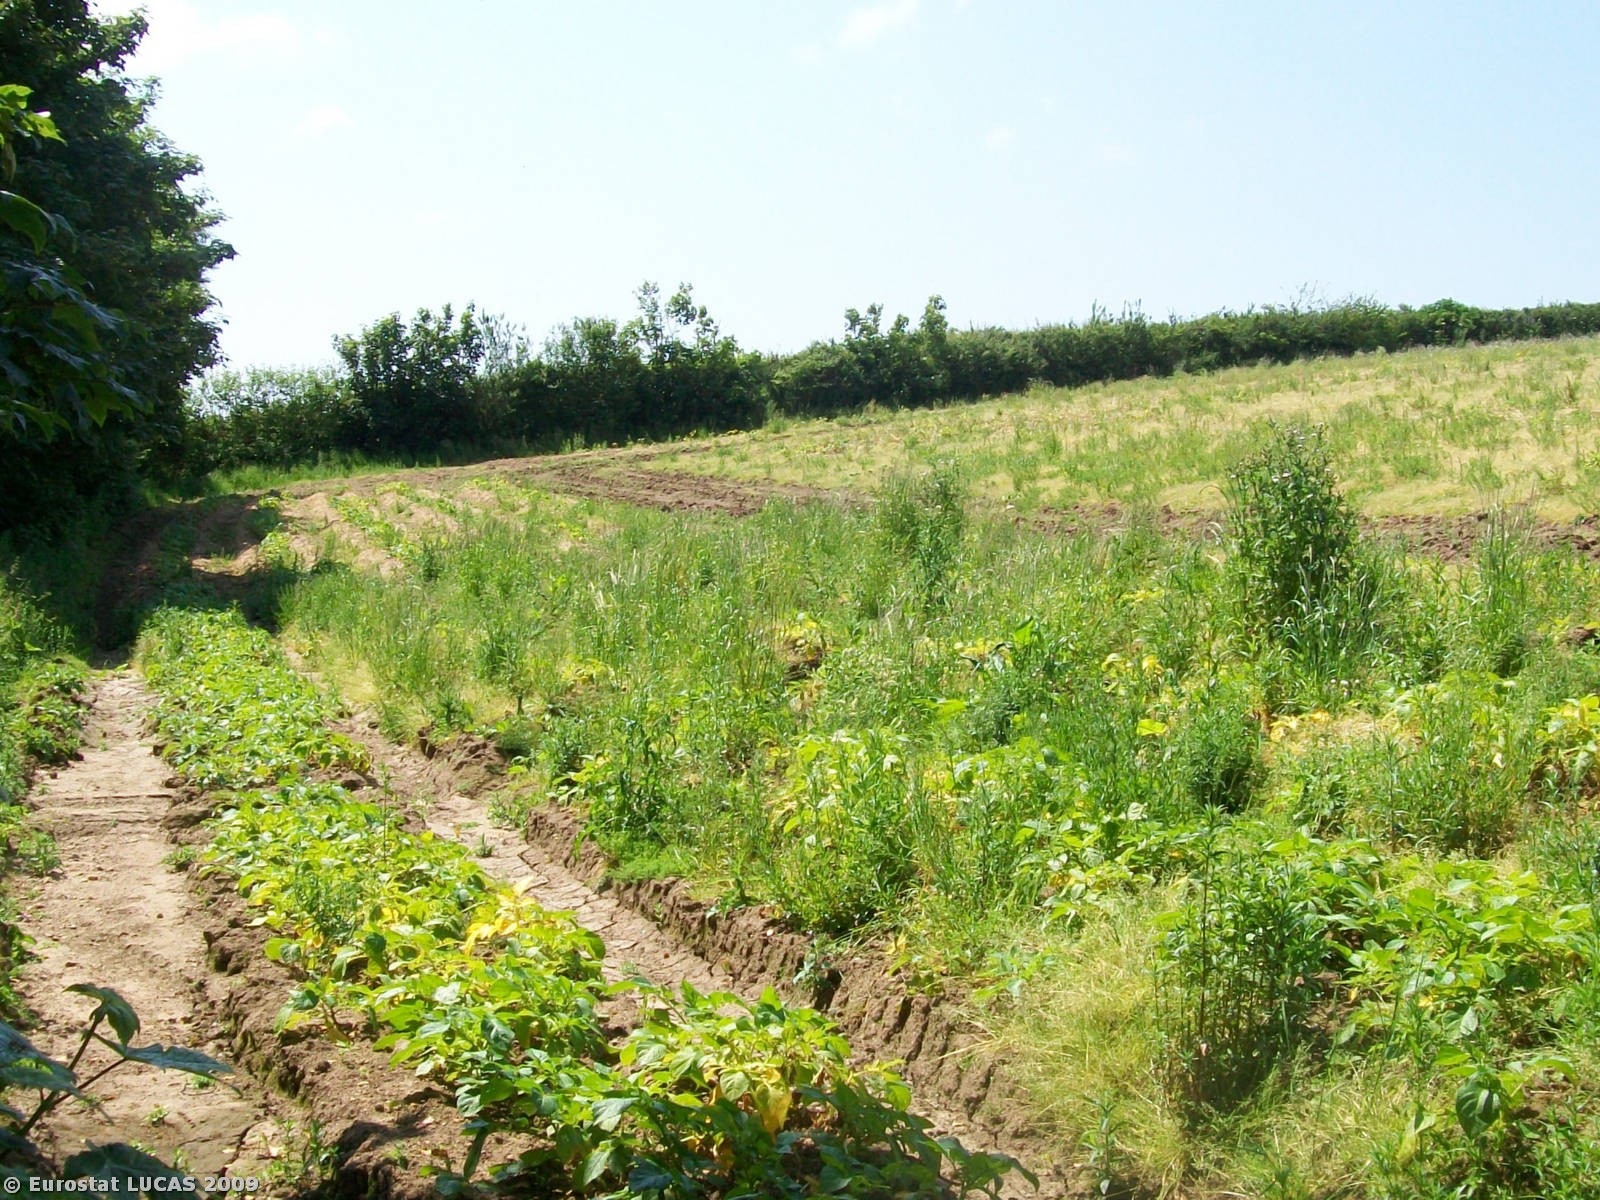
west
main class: Grassland
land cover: Spontaneously vegetated surfaces
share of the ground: > 75 %
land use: Fallow land
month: June
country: GB
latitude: 50.1929
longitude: -5.1202
